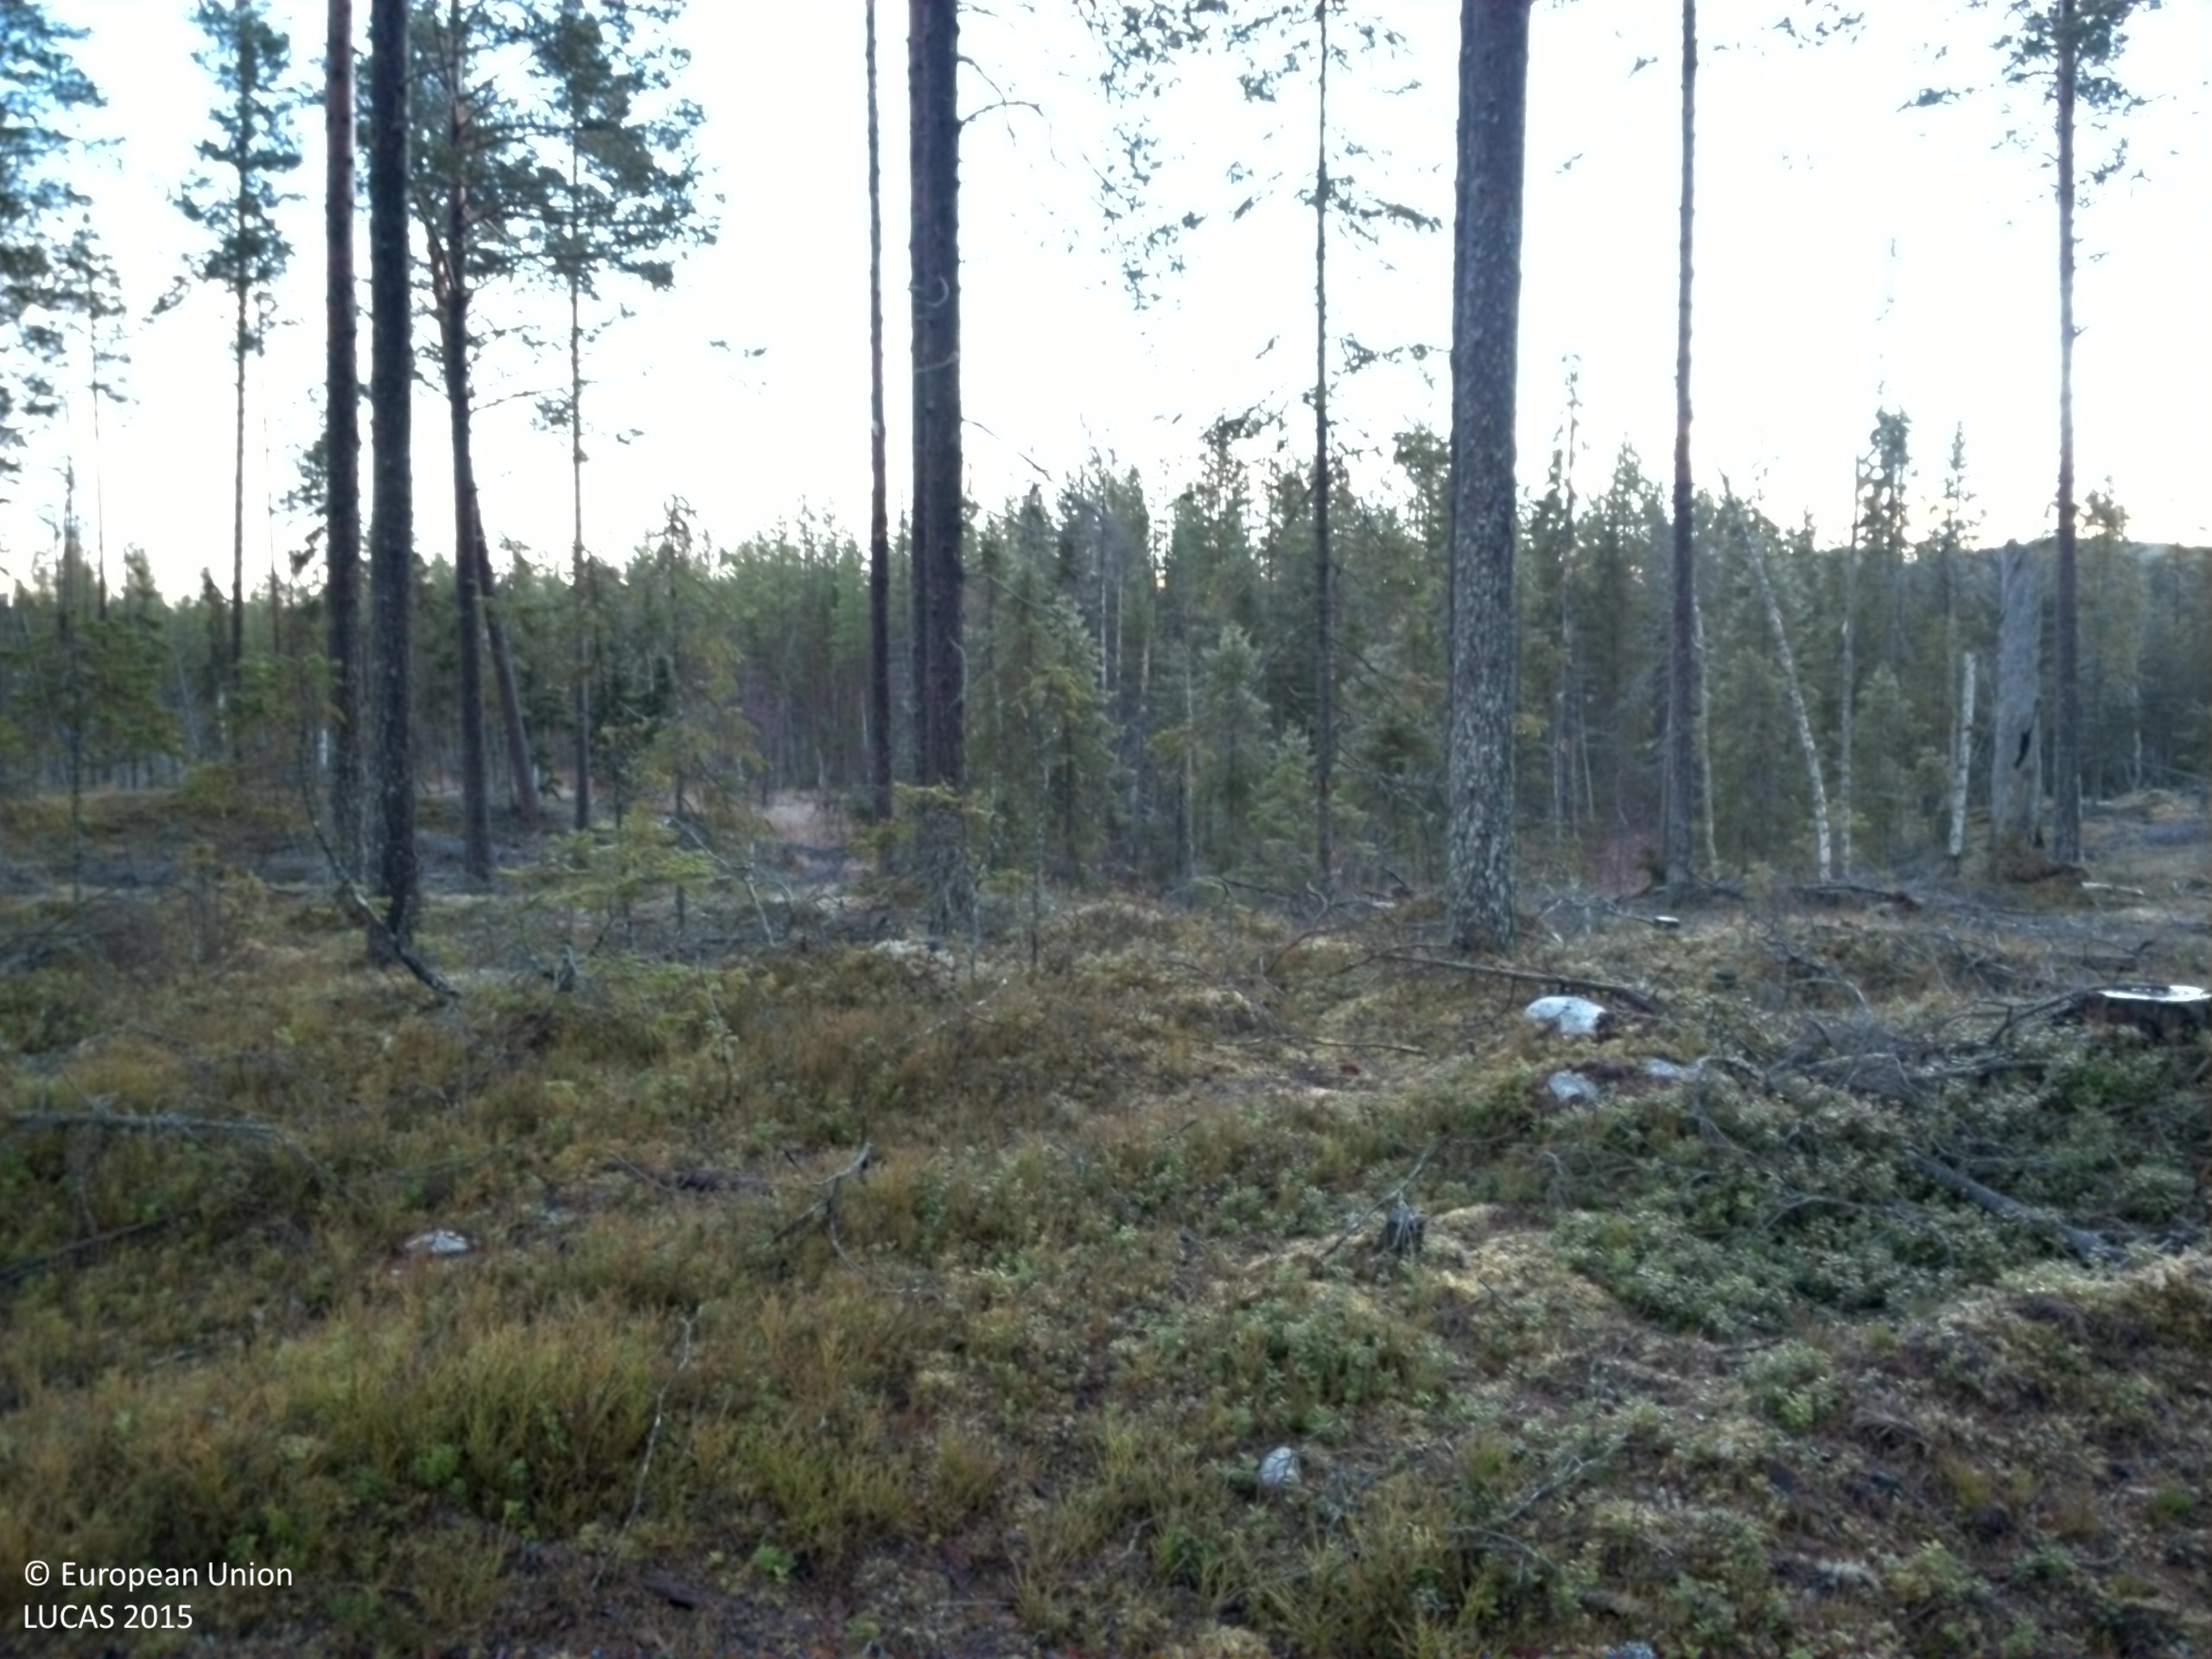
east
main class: Woodland
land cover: Pine dominated coniferous woodland
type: boreal forest
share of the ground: 25 - 50 %
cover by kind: shrubs 50 %, coniferous forest trees 25 %, lichens and mosses 20 %, broadleaved forest trees 5 %
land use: Forestry
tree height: > 5 m
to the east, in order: Pine dominated coniferous woodland; Spruce dominated mixed woodland; Rivers and streams; Spruce dominated mixed woodland; Pine dominated mixed woodland; Spruce dominated mixed woodland; Pine dominated coniferous woodland
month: November
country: SE
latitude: 63.8940
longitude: 16.2657
